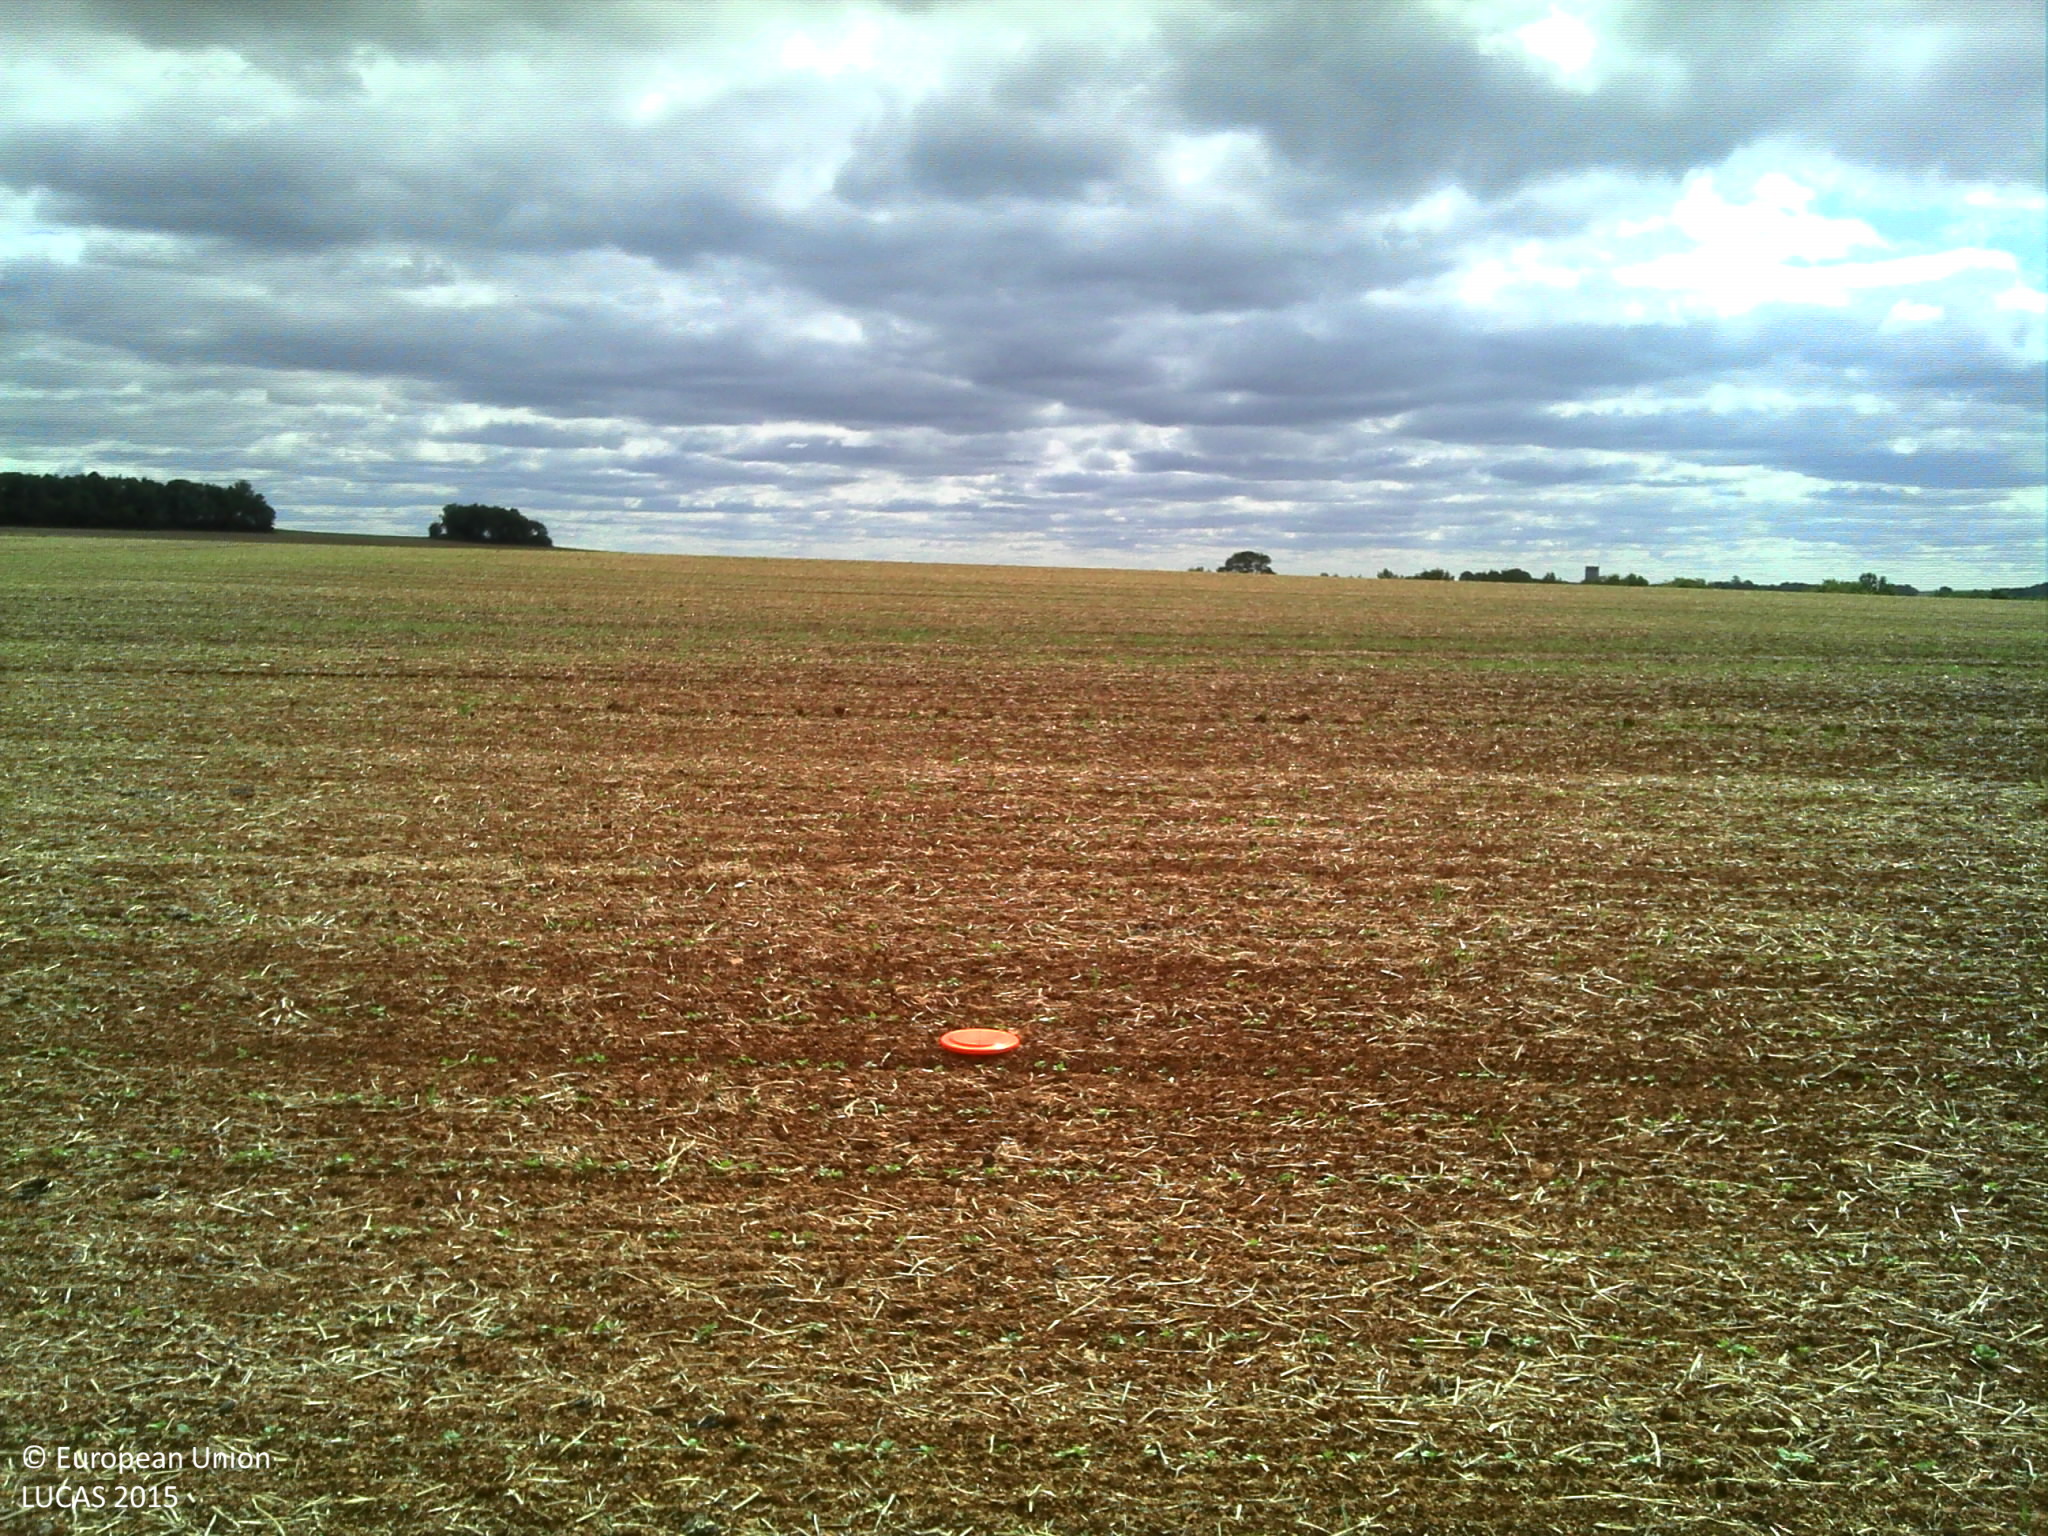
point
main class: Cropland
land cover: Barley
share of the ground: 10 - 25 %
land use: Agriculture (excluding fallow land and kitchen gardens)
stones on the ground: 10 - 25 %
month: September
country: FR
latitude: 47.5382
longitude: 4.7254
